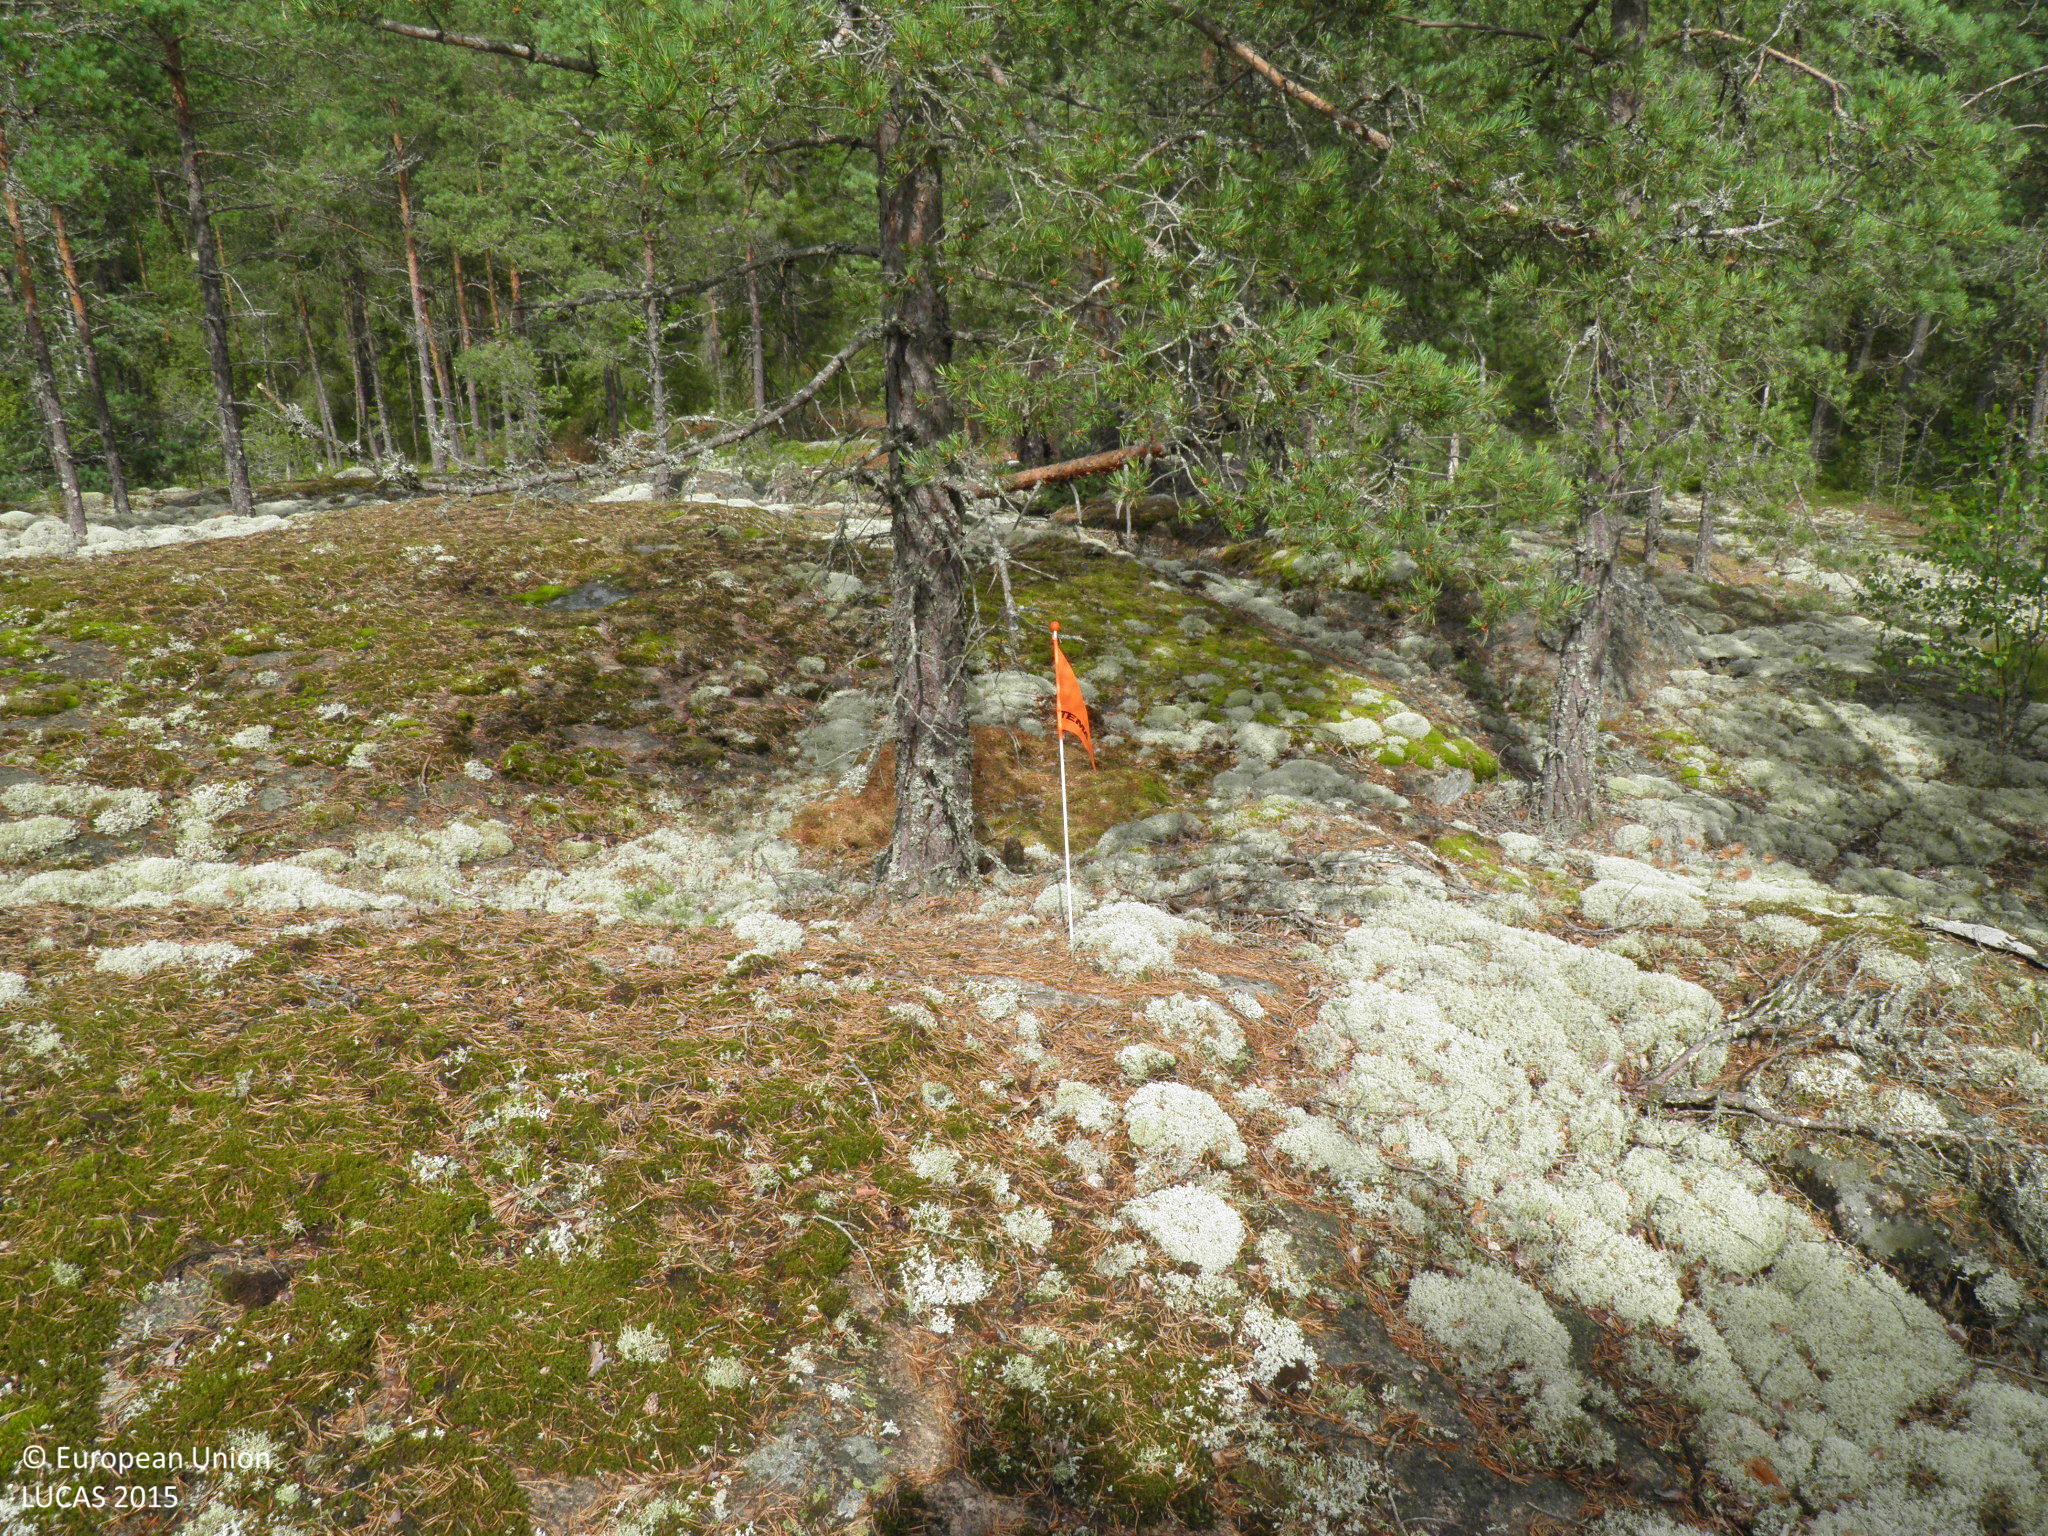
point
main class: Woodland
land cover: Pine dominated coniferous woodland
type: hemiboreal forest and nemoral coniferous forest and mixed broadleaved-coniferous forest
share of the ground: 25 - 50 %
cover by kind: lichens and mosses 50 %, coniferous forest trees 25 %, unconsolidated bare surface 20 %, broadleaved forest trees 5 %
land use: Forestry
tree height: > 5 m
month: July
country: FI
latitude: 60.5509
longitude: 21.6737
